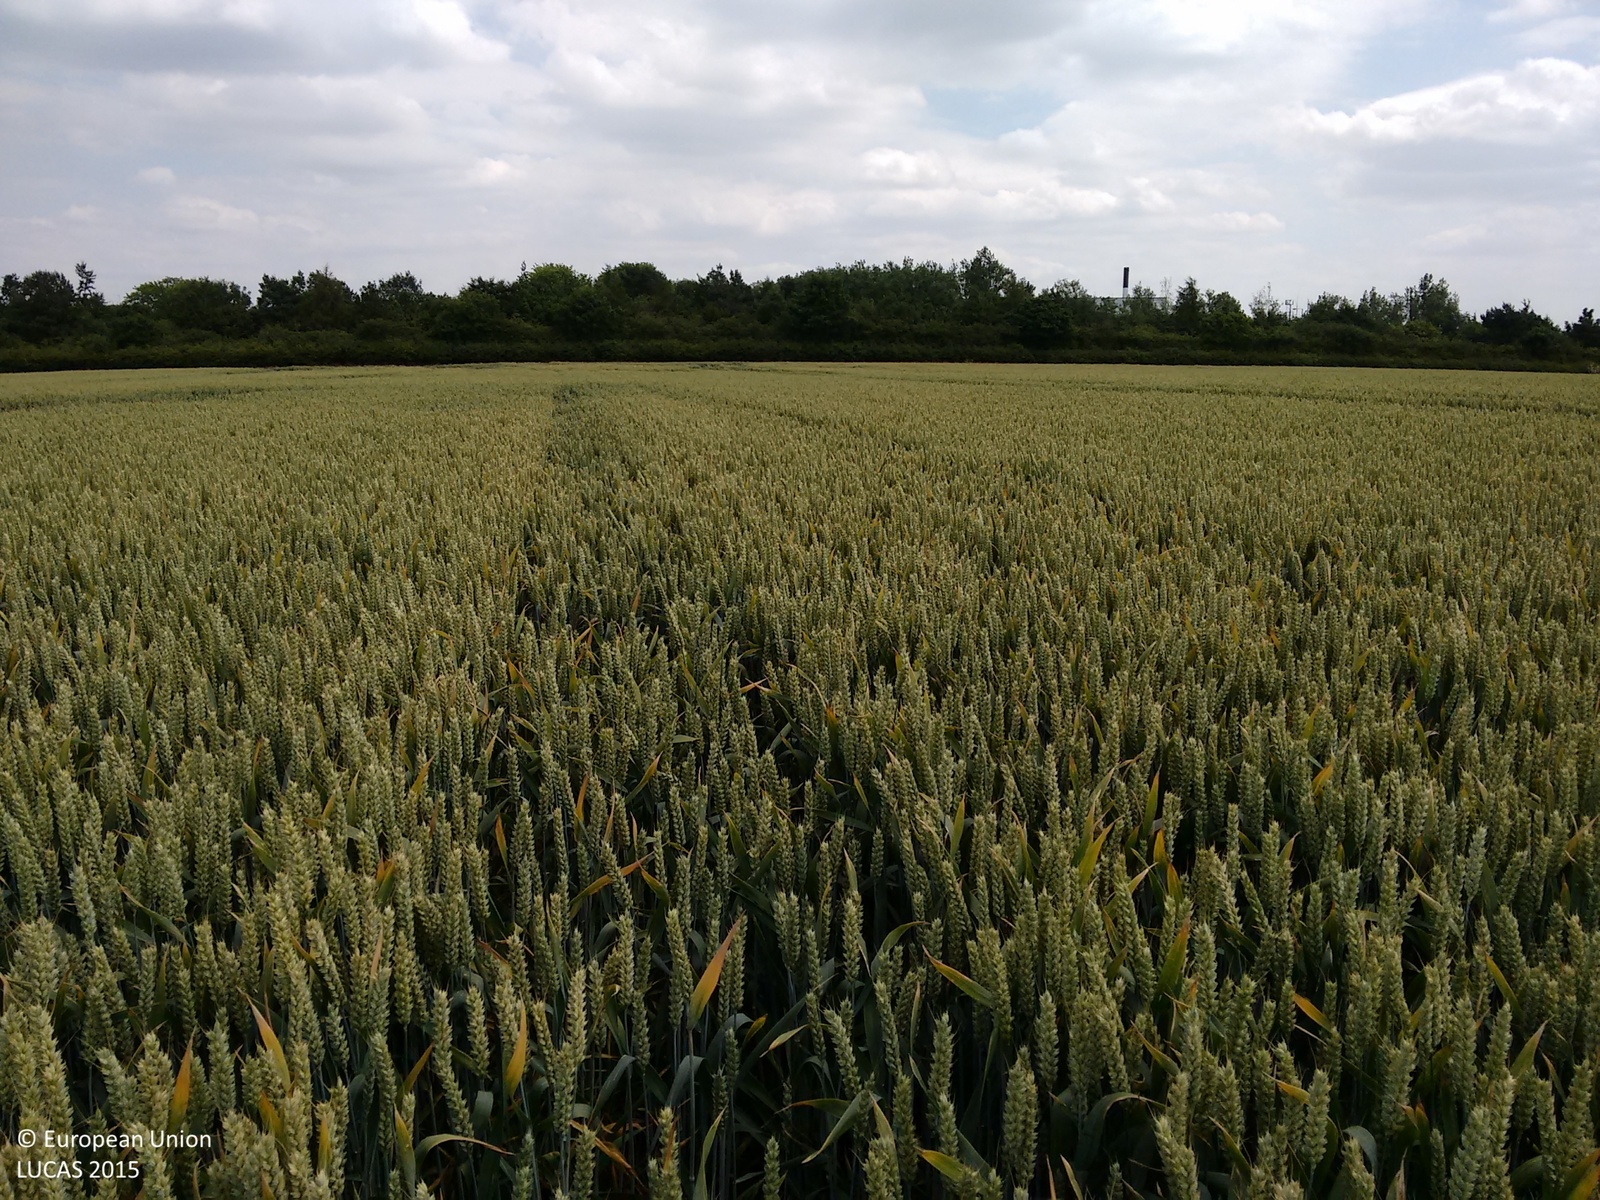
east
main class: Cropland
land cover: Common wheat
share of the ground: > 75 %
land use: Agriculture (excluding fallow land and kitchen gardens)
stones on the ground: < 10 %
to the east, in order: Common wheat; Other bare soil; Grass margins; Managed hedges; Grass margins; Paved roads, cycling and walking lanes; Grassland without tree/shrub cover; Broadleaved woodland; Sand; Paved roads, cycling and walking lanes; Grass margins
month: July
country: GB
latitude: 52.4690
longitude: -0.7427
